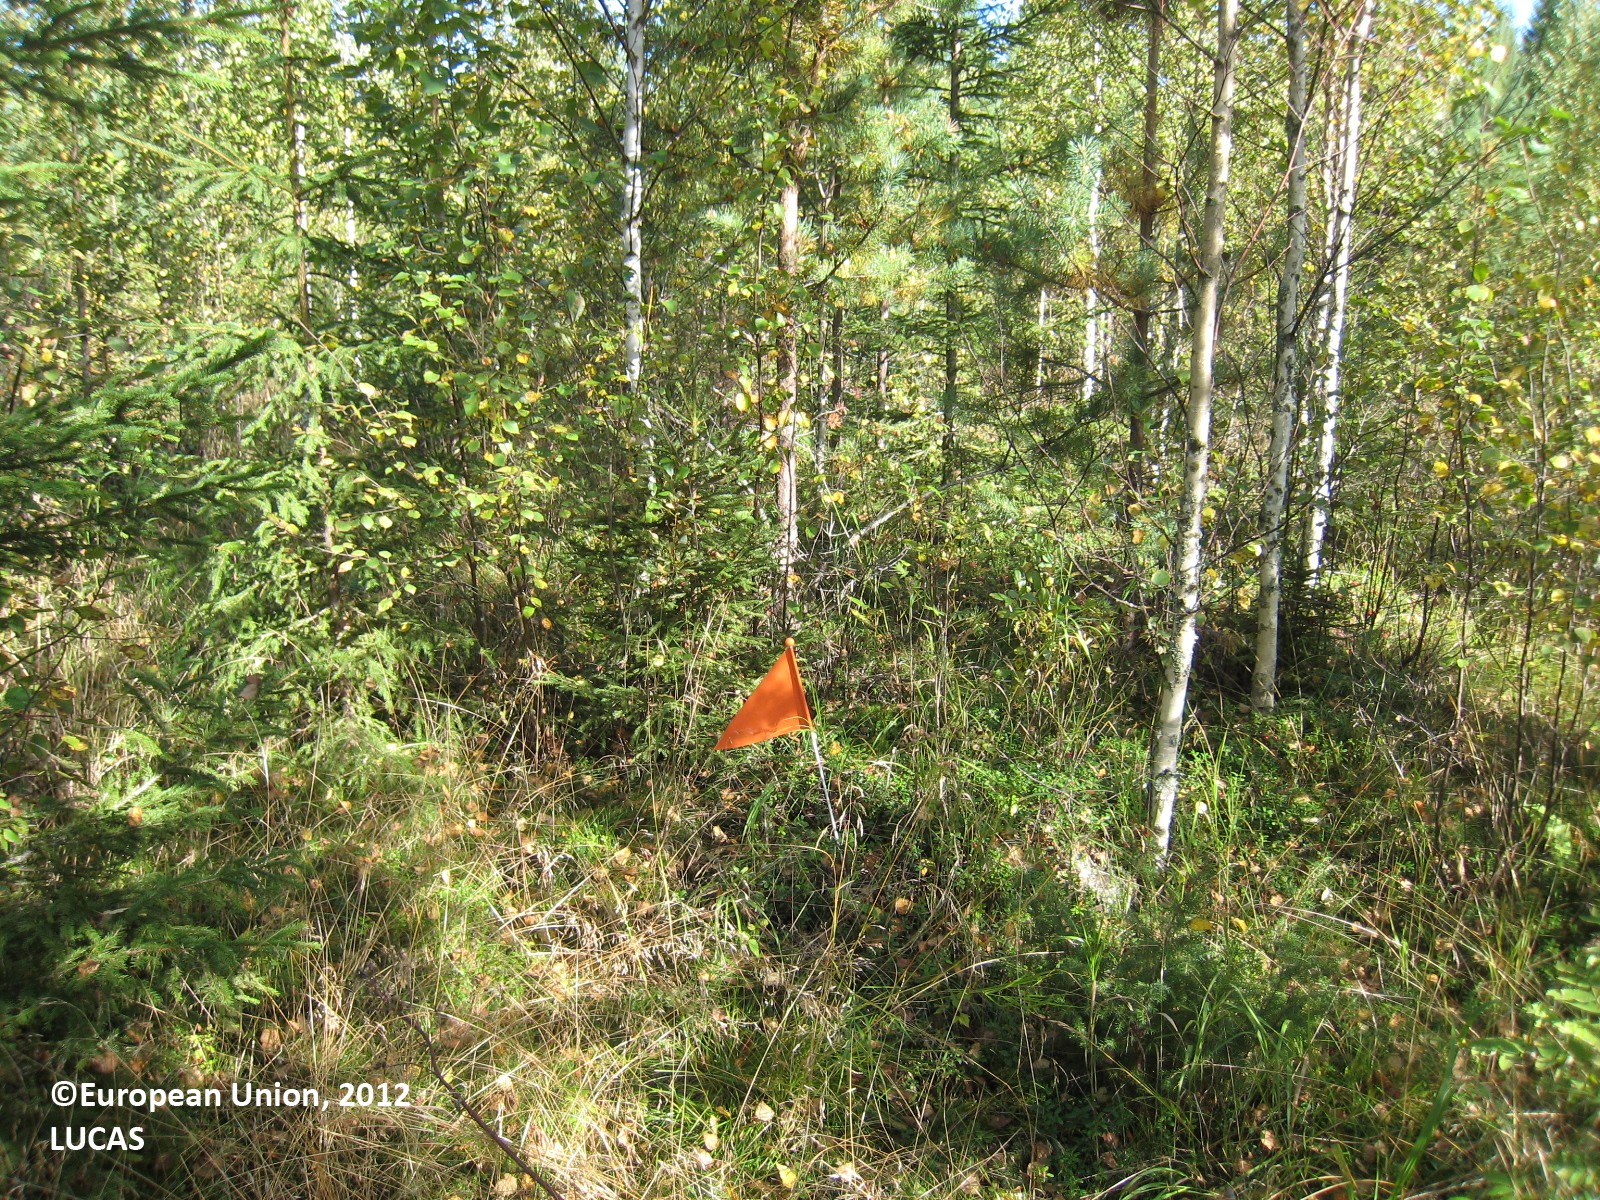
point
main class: Woodland
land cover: Other mixed woodland
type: boreal forest
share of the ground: > 75 %
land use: Forestry
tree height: > 5 m
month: September
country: FI
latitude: 63.0068
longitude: 26.8287
